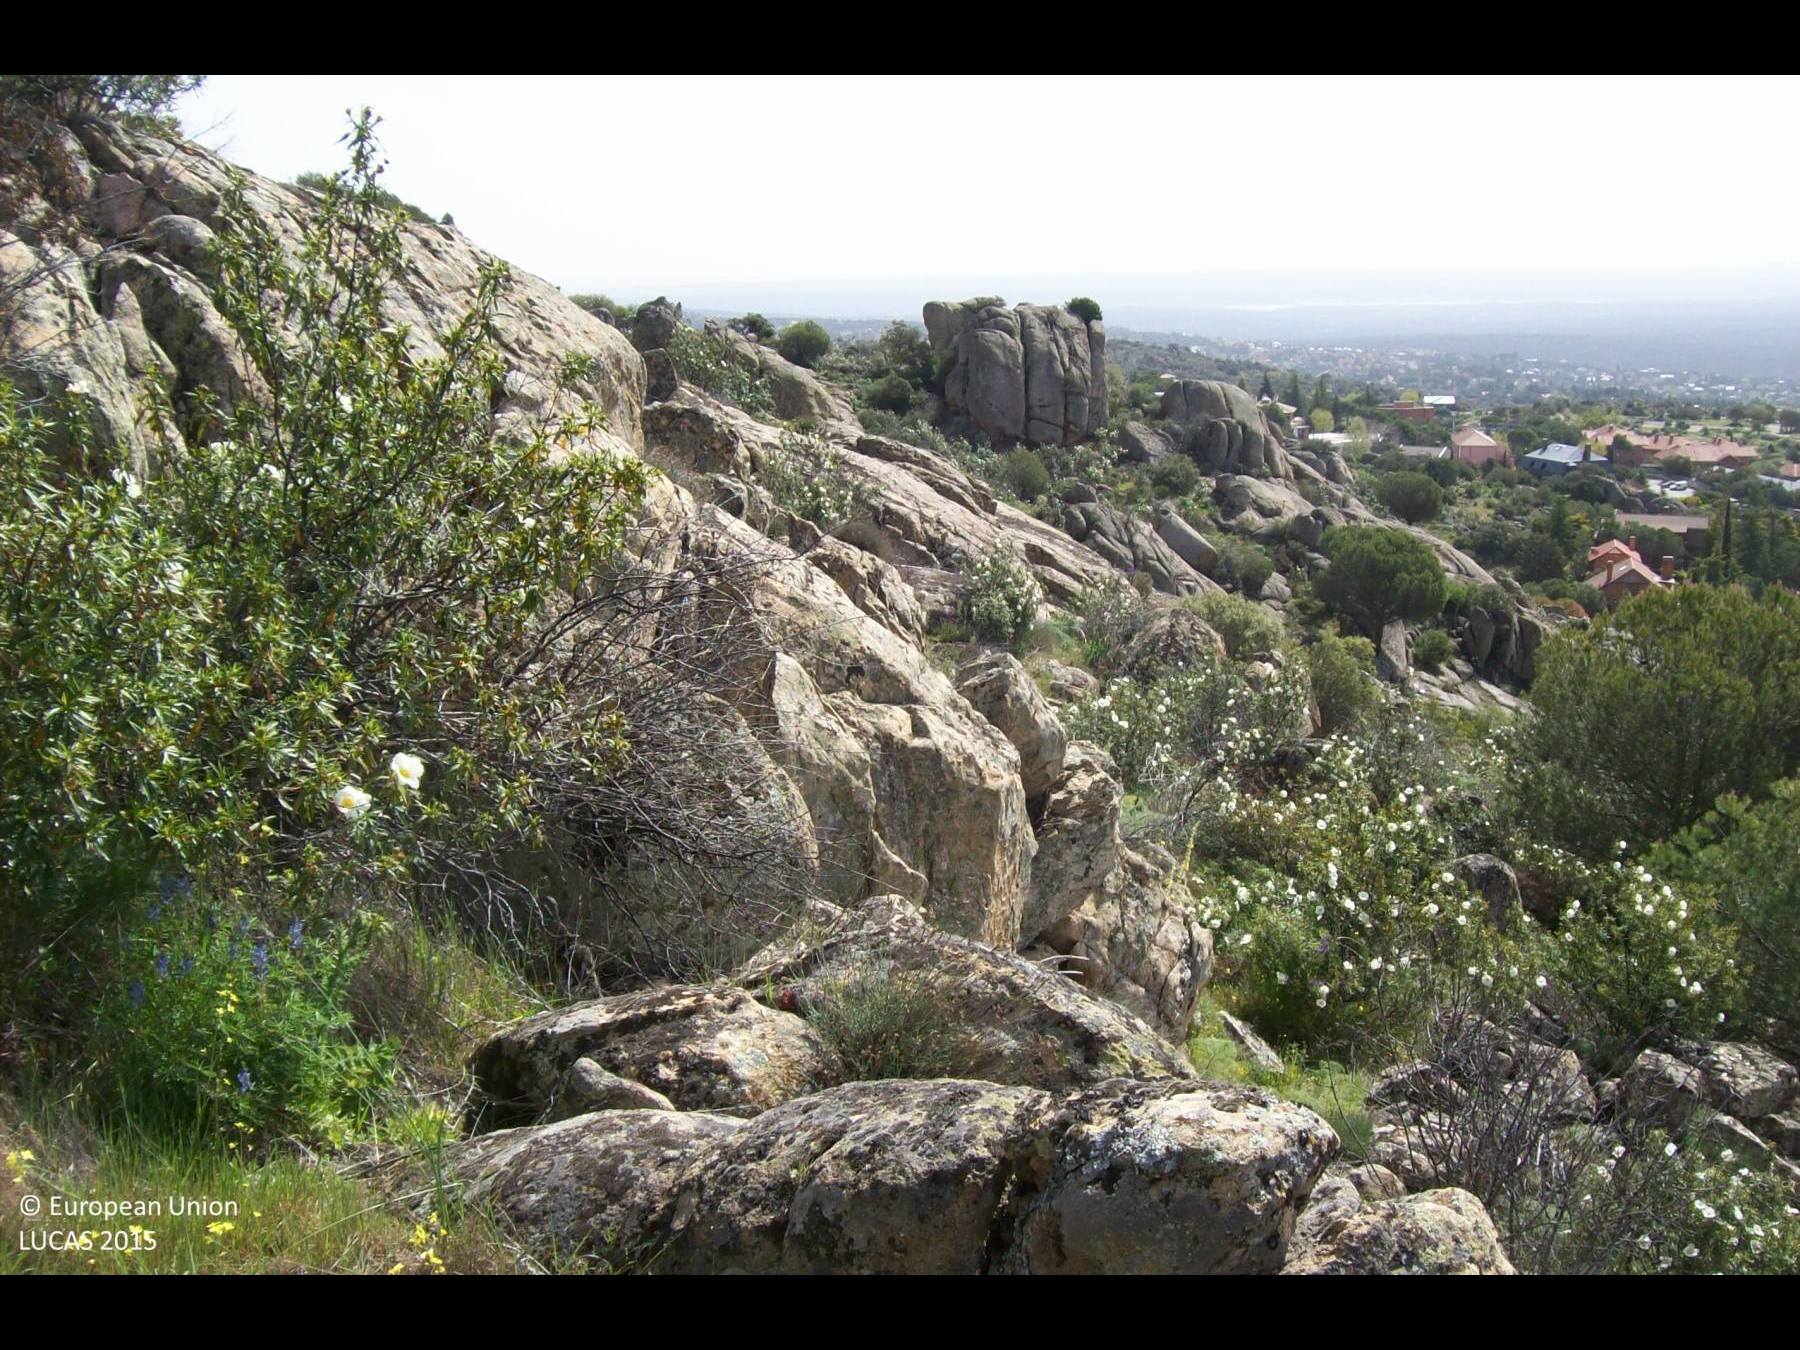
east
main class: Shrubland
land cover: Shrubland with sparse tree cover
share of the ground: > 75 %
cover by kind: consolidated bare surface 55 %, shrubs 25 %, herbaceous plants 15 %, coniferous forest trees 5 %
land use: Semi-natural and natural areas not in use
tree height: < 5 m
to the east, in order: Shrubland with sparse tree cover; Rocks and stones; Shrubland with sparse tree cover
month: April
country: ES
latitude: 40.5882
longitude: -3.9257
